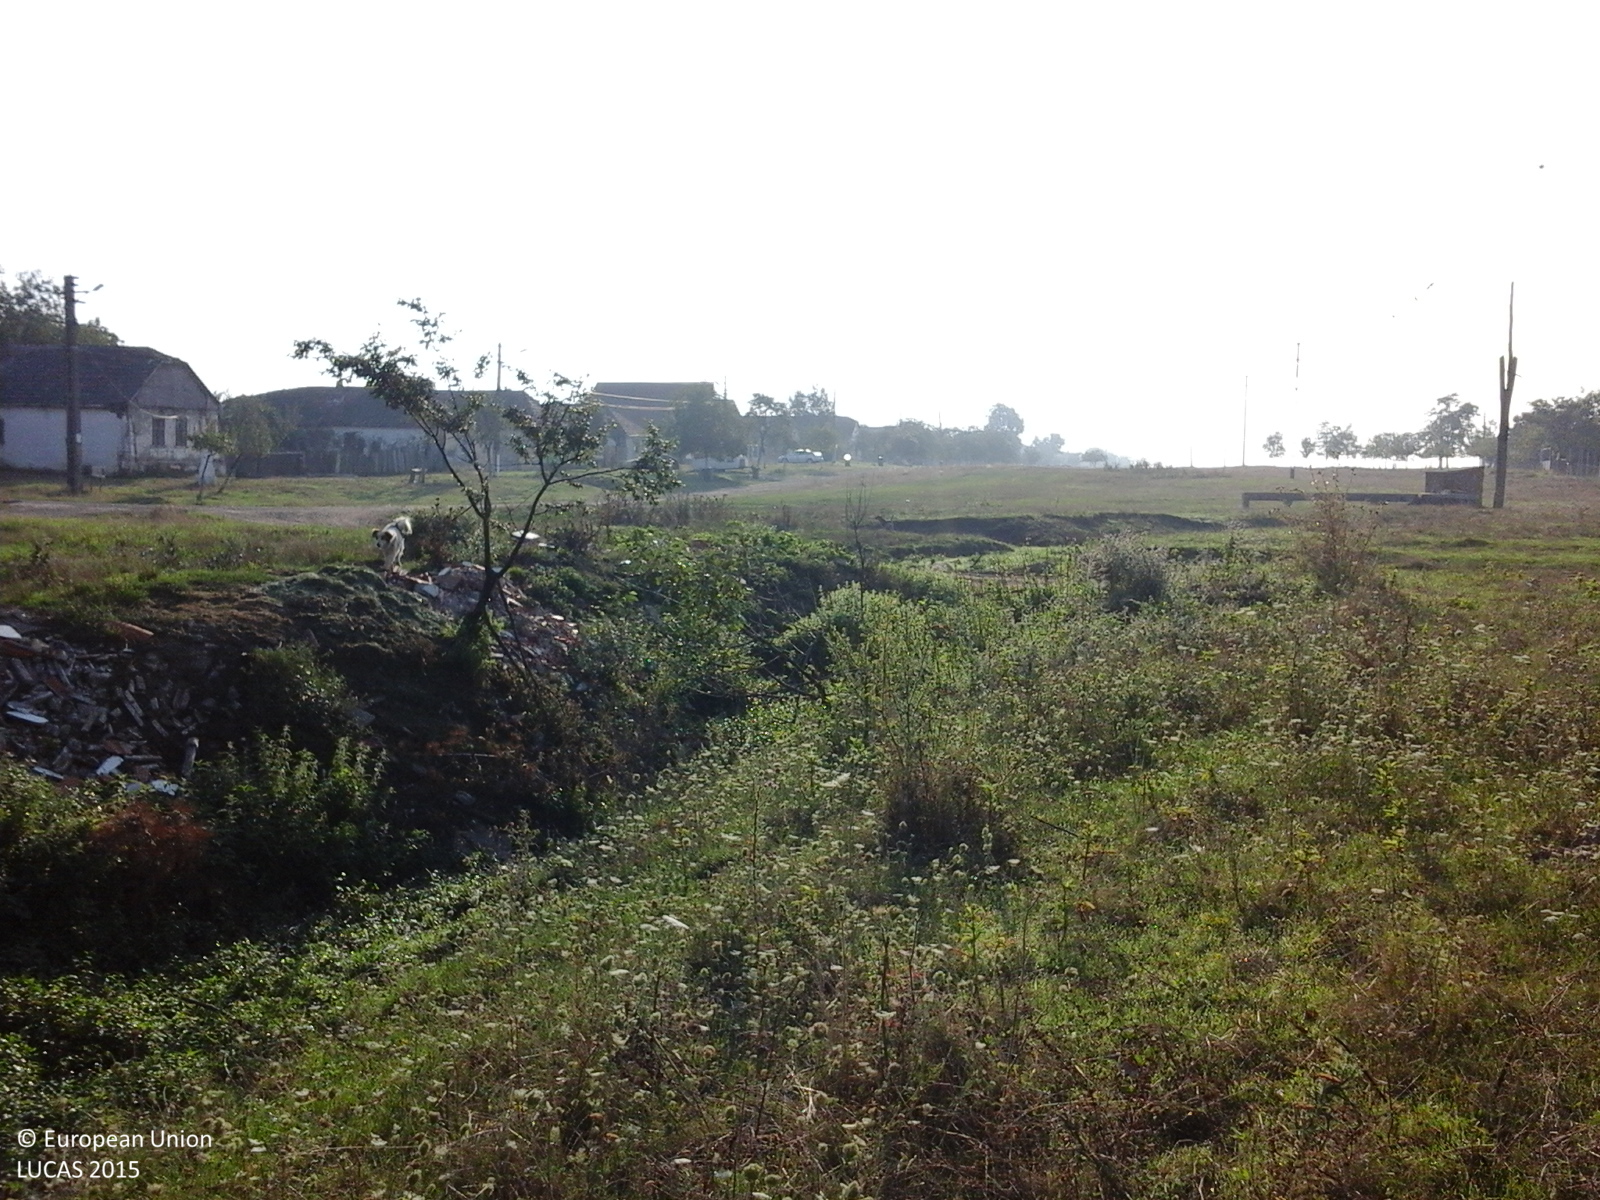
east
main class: Grassland
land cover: Grassland without tree/shrub cover
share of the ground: > 75 %
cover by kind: herbaceous plants 100 %
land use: Agriculture (excluding fallow land and kitchen gardens)
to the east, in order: Grassland without tree/shrub cover; Ditches and canals; Grassland without tree/shrub cover; Tracks; Grassland without tree/shrub cover; Tracks; Grassland without tree/shrub cover; Electric lines; Abandoned hedges; Grassland without tree/shrub cover; Artificial constructions in urban areas; Other fruit trees and berries; Grass margins; Paved roads, cycling and walking lanes; Grass margins; Ditches and canals; Grassland without tree/shrub cover; Artificial constructions in urban areas
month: August
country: RO
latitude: 46.0971
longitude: 21.4568
